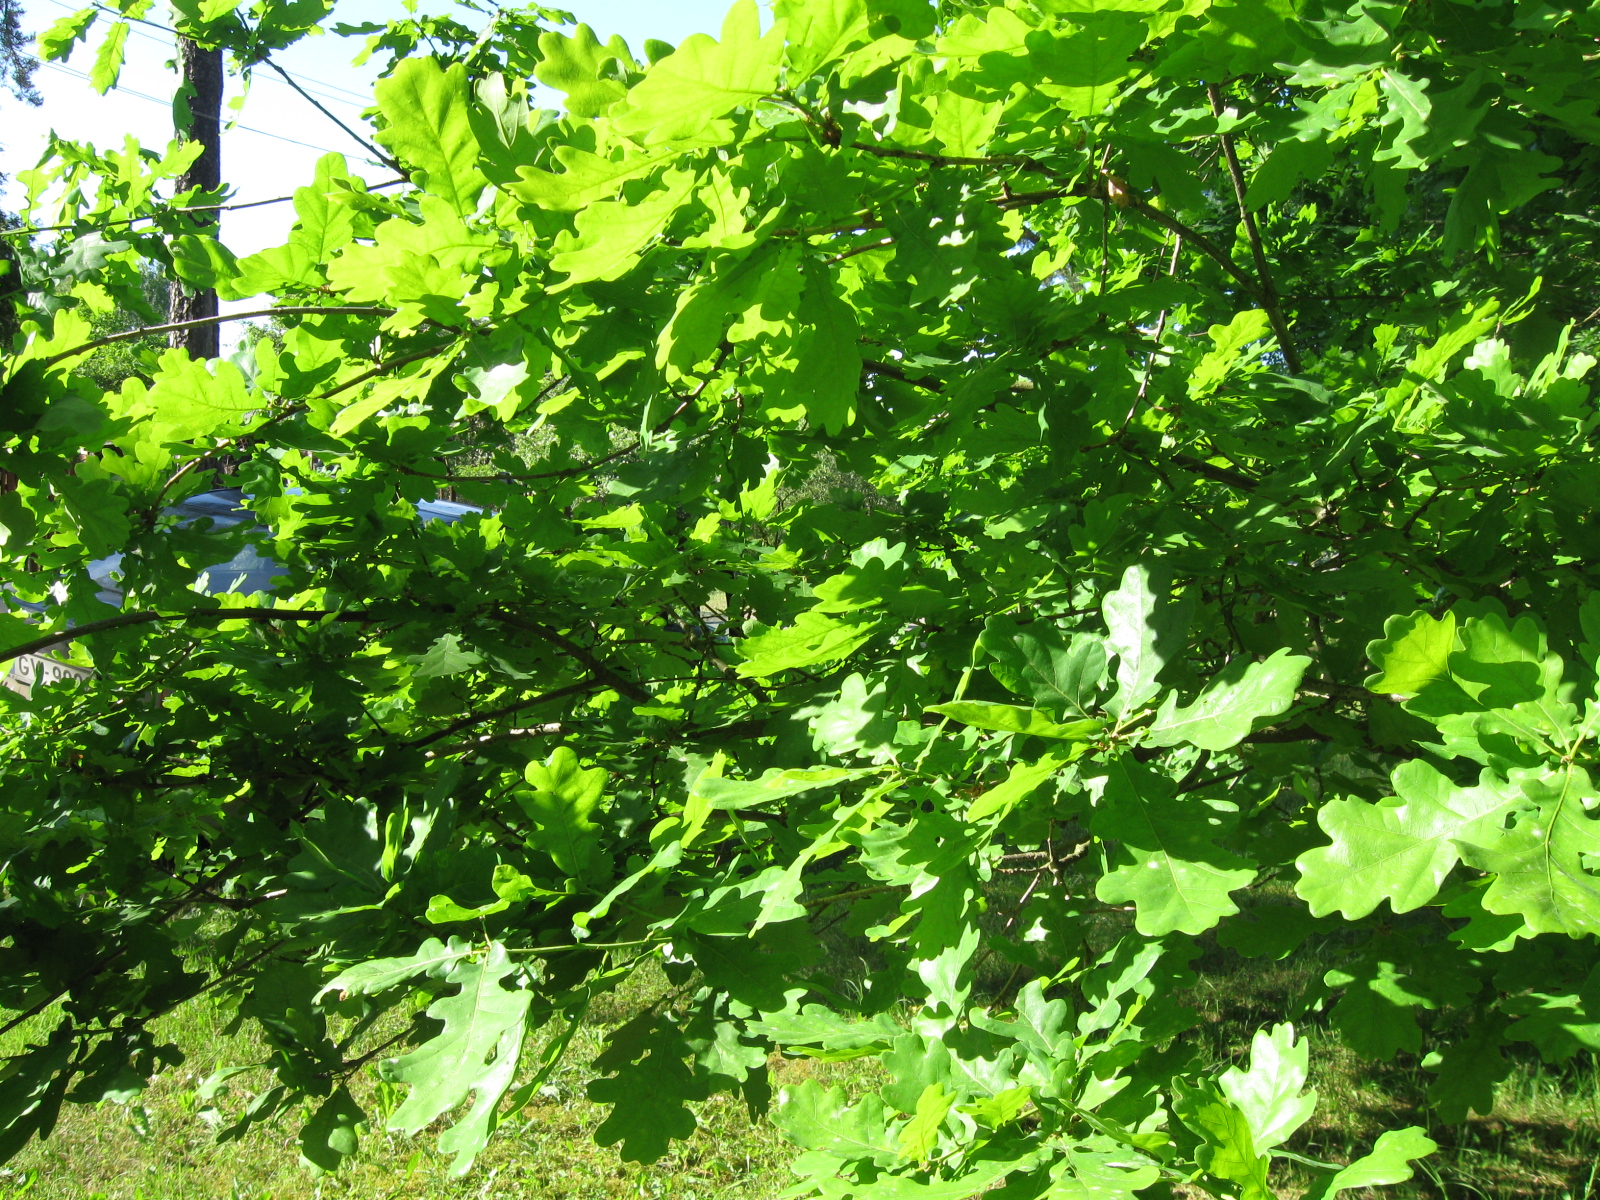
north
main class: Woodland
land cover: Pine dominated mixed woodland
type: hemiboreal forest and nemoral coniferous forest and mixed broadleaved-coniferous forest
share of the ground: > 75 %
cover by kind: broadleaved forest trees 60 %, coniferous forest trees 40 %
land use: Community services
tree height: > 5 m
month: June
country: LT
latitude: 54.8871
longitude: 23.9807
